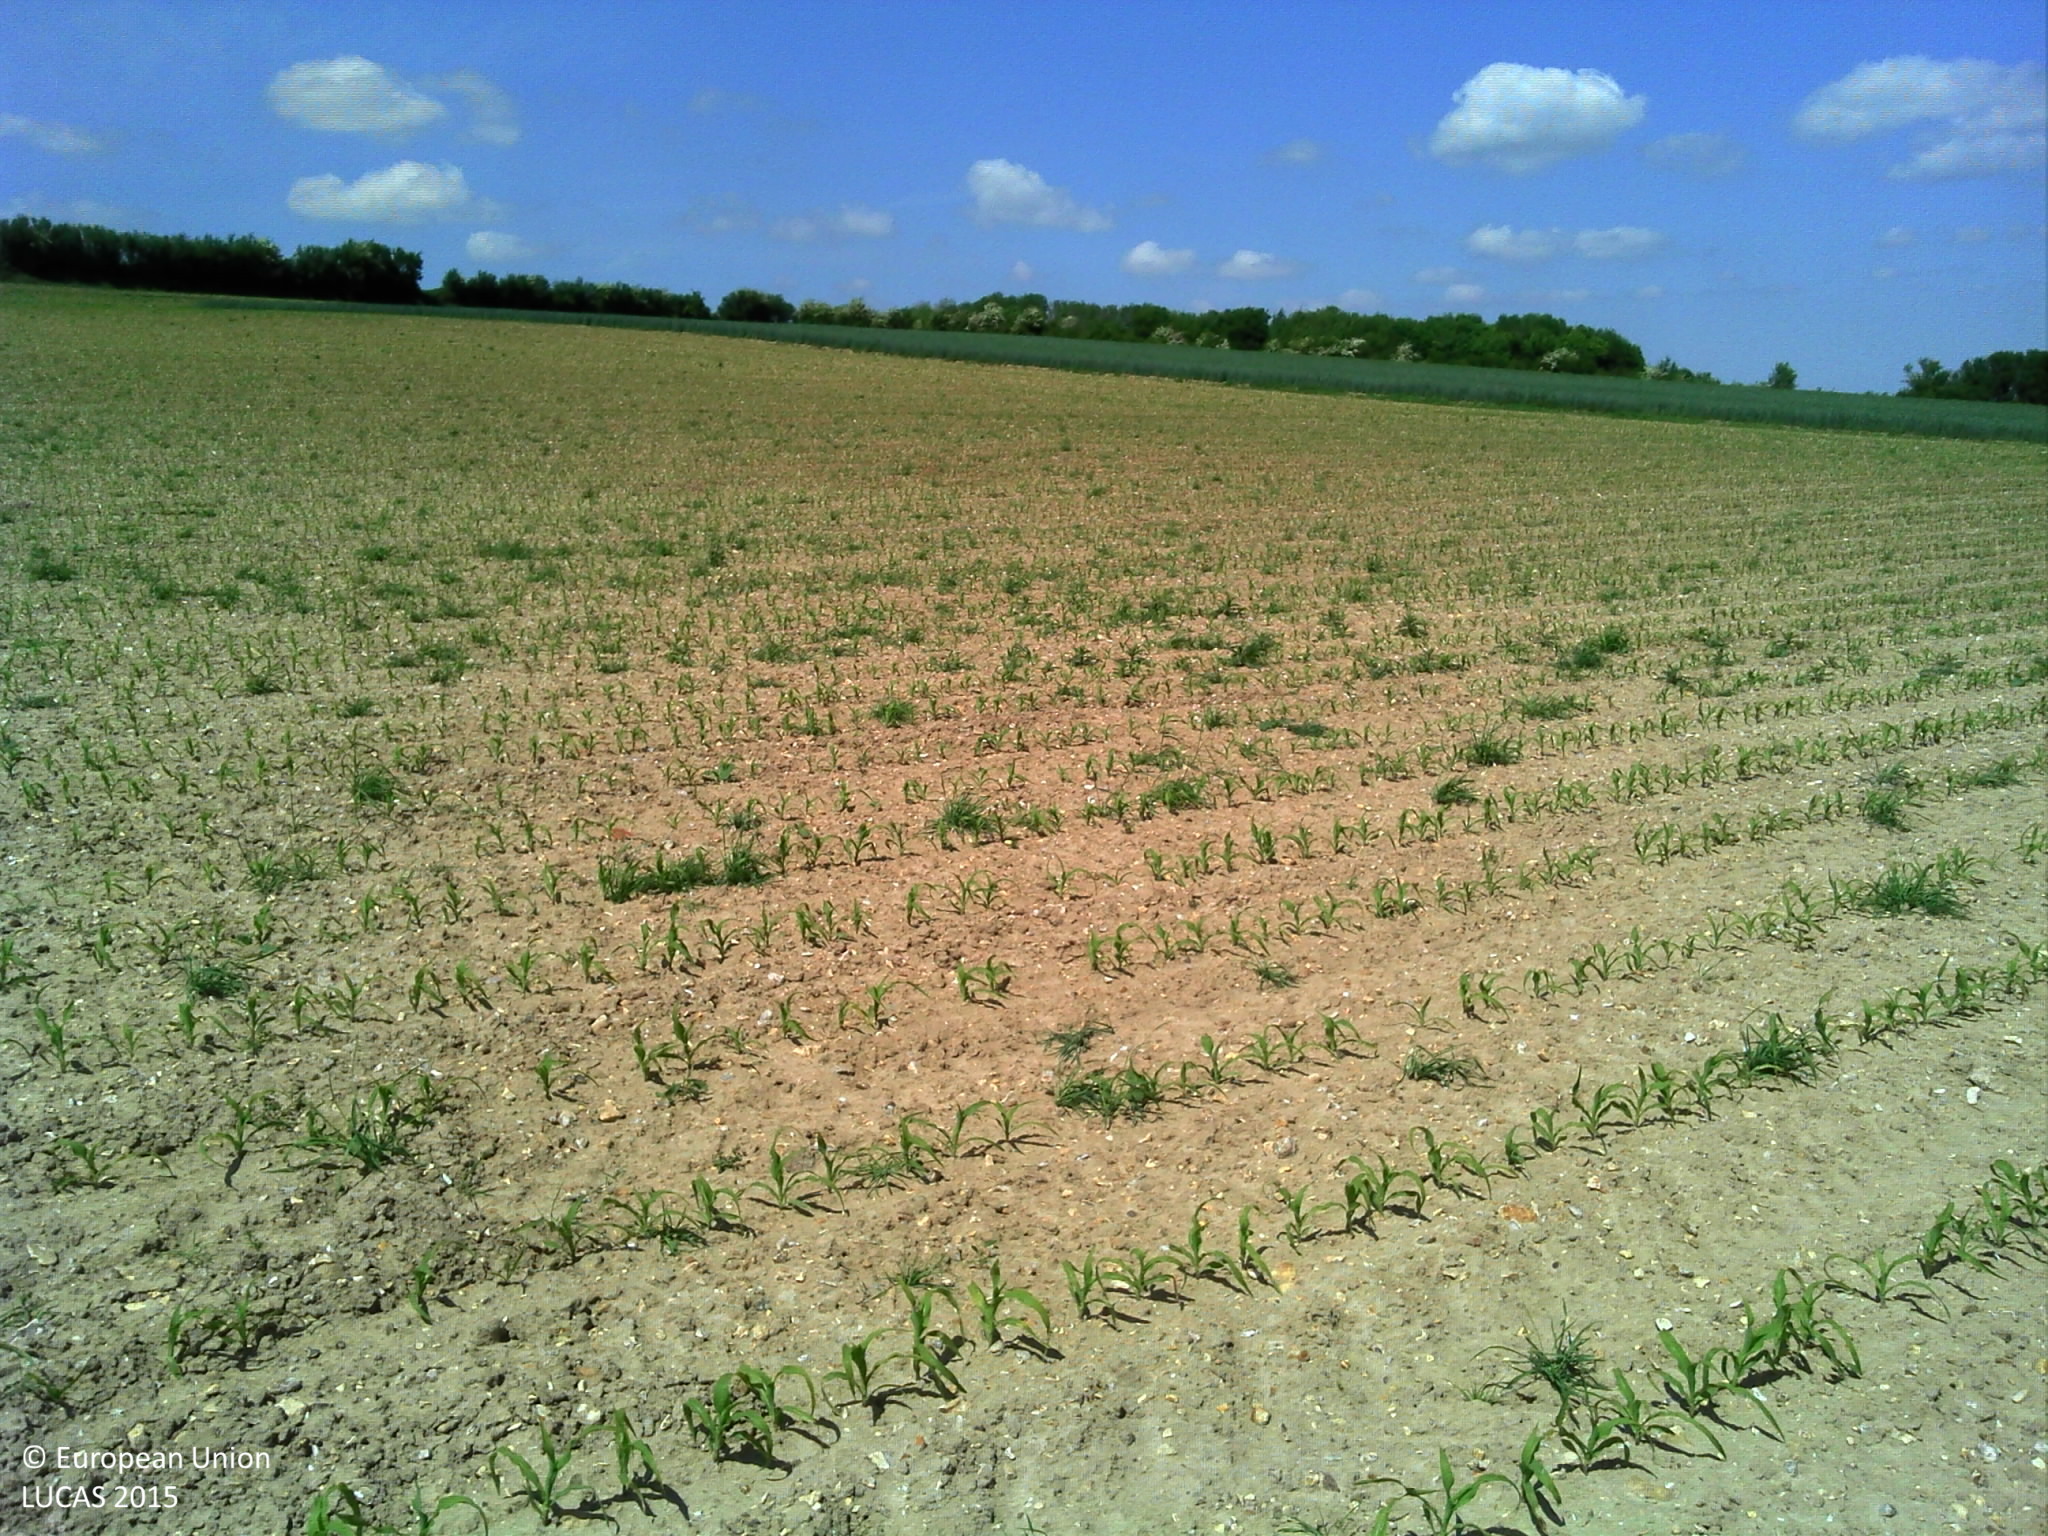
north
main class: Cropland
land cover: Maize
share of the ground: < 10 %
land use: Agriculture (excluding fallow land and kitchen gardens)
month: May
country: FR
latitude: 50.5376
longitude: 2.2964
